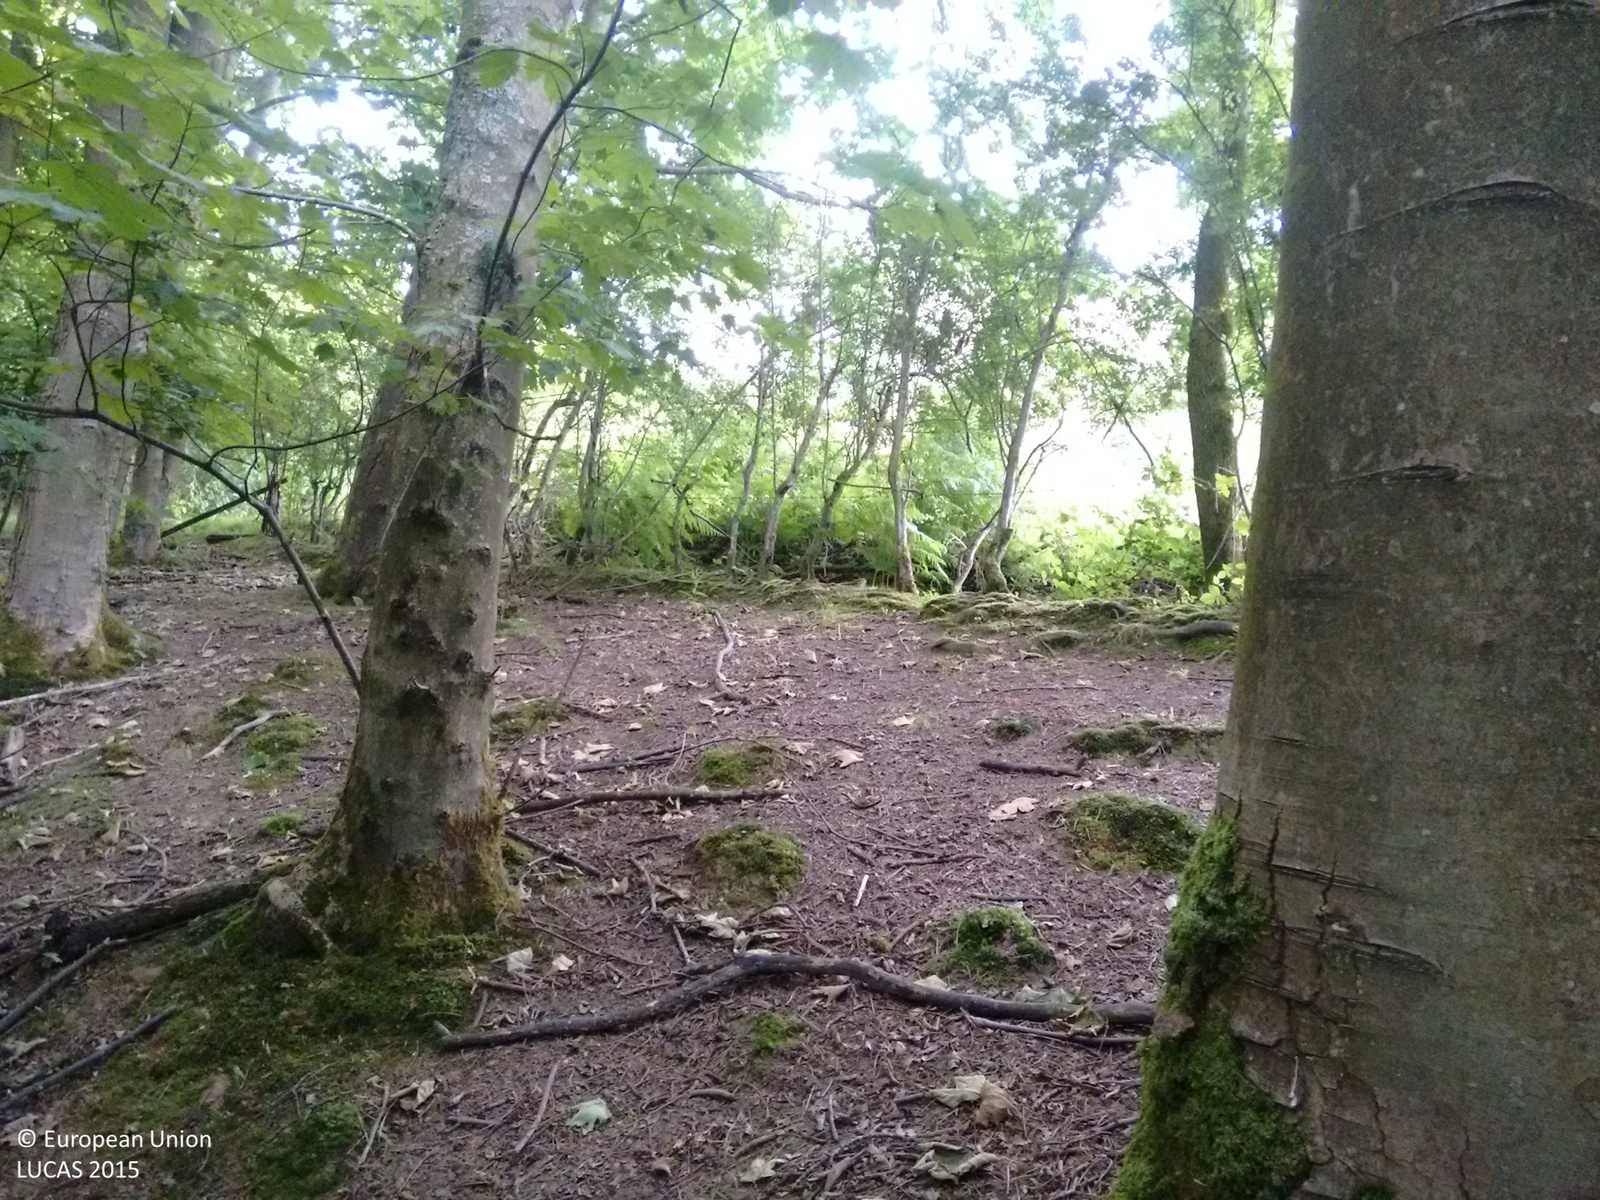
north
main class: Woodland
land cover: Broadleaved woodland
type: mesophytic deciduous forest
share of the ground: > 75 %
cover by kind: broadleaved forest trees 100 %
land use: Agriculture (excluding fallow land and kitchen gardens)
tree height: > 5 m
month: July
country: GB
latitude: 51.0608
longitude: -0.0642
